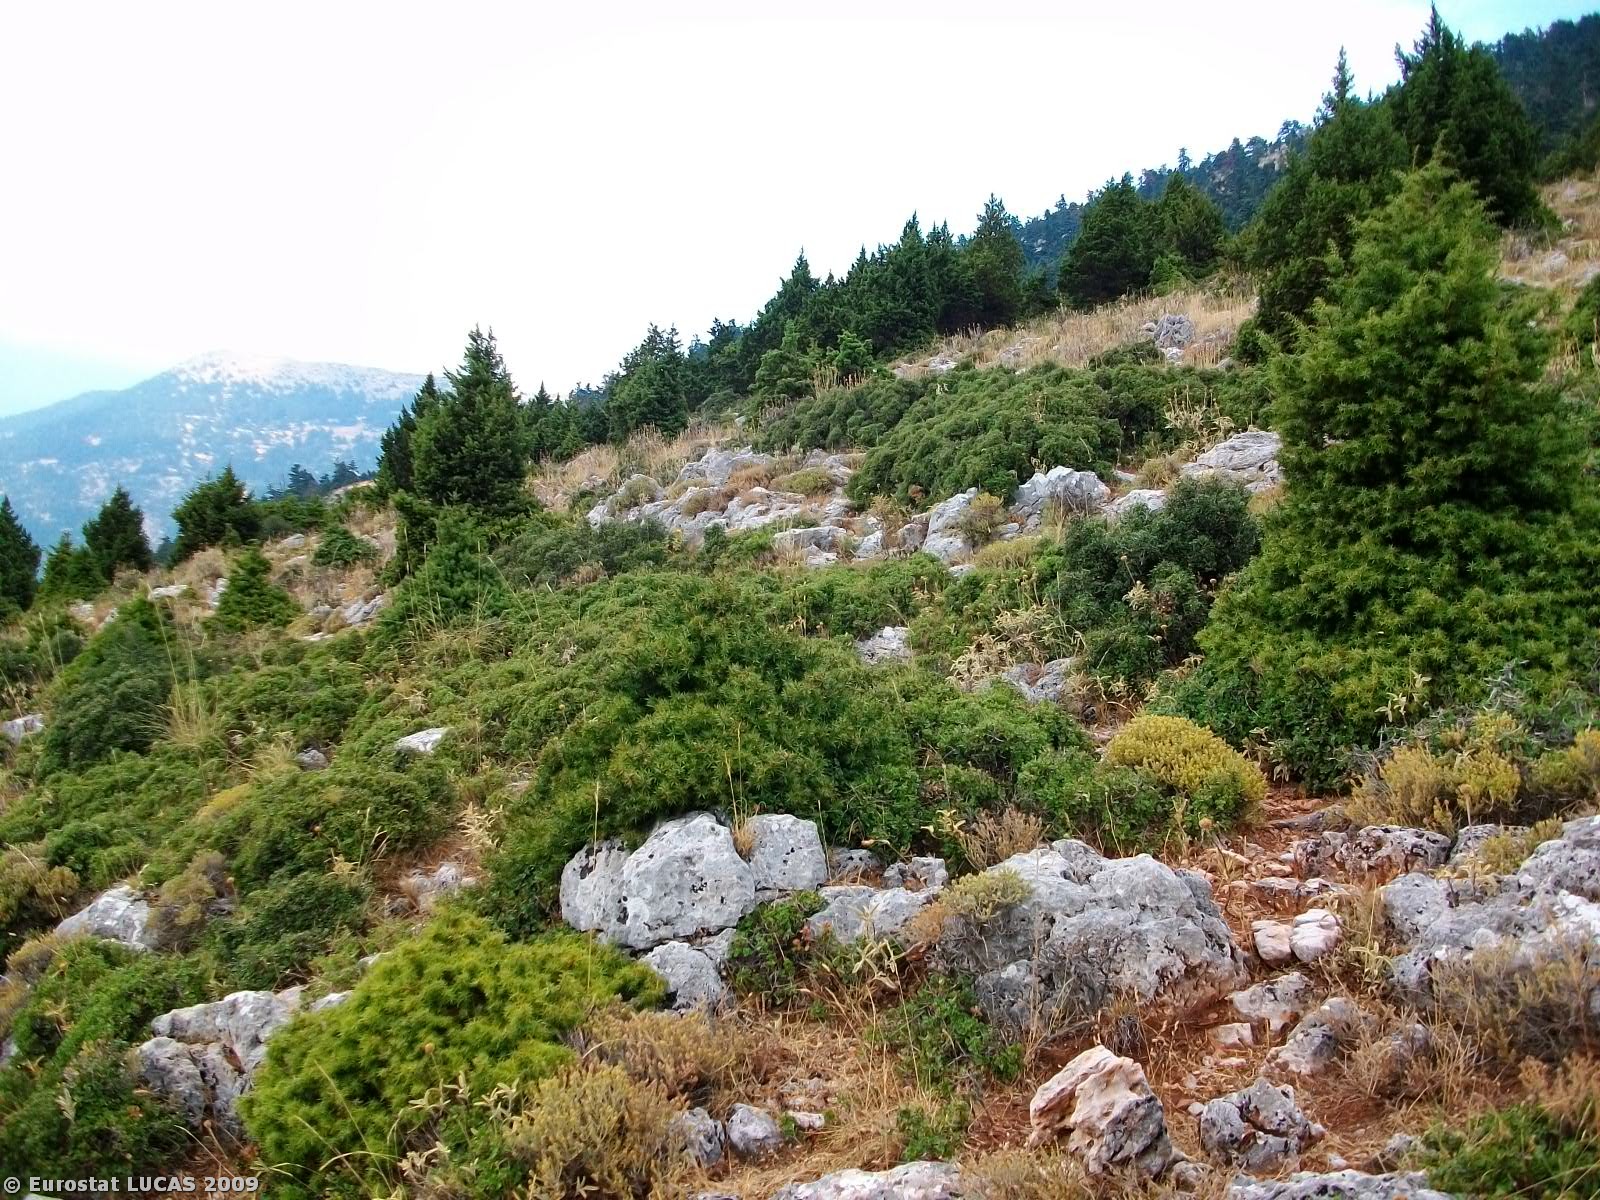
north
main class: Woodland
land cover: Coniferous woodland
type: coniferous forest of the mediterranean region
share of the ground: 10 - 25 %
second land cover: Shrubland with sparse tree cover
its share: 25 - 50 %
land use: Forestry
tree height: > 5 m
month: August
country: GR
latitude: 37.0306
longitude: 22.7616
